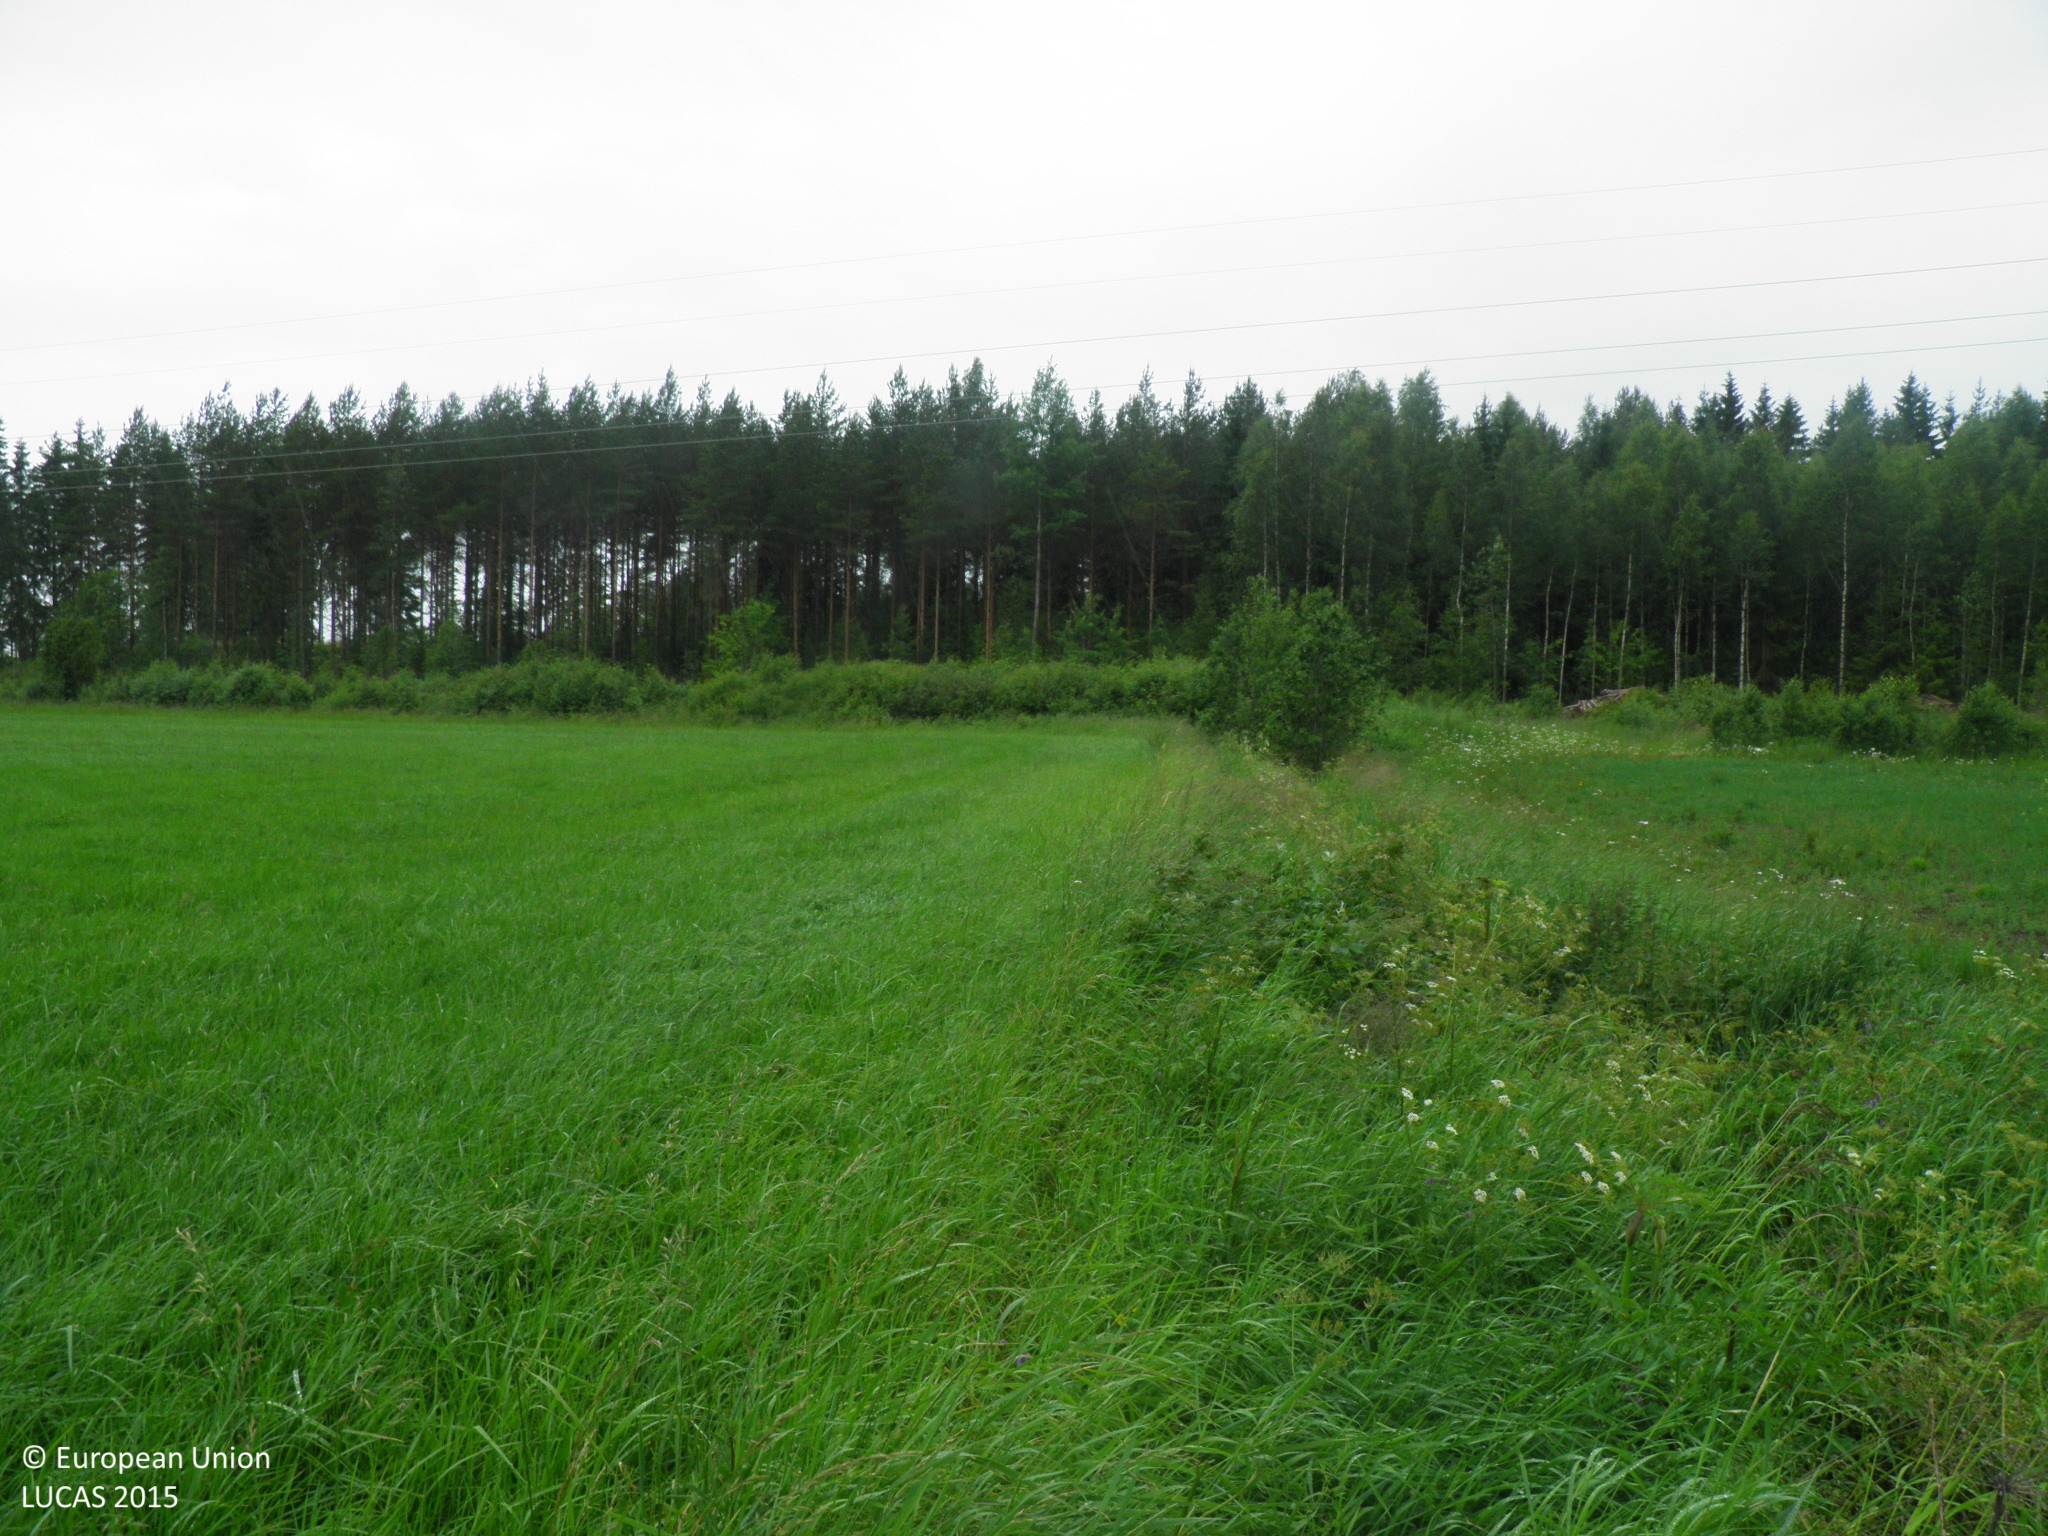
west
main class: Cropland
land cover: Temporary grasslands
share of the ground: > 75 %
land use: Agriculture (excluding fallow land and kitchen gardens)
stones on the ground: < 10 %
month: July
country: FI
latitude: 60.6556
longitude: 22.7874
